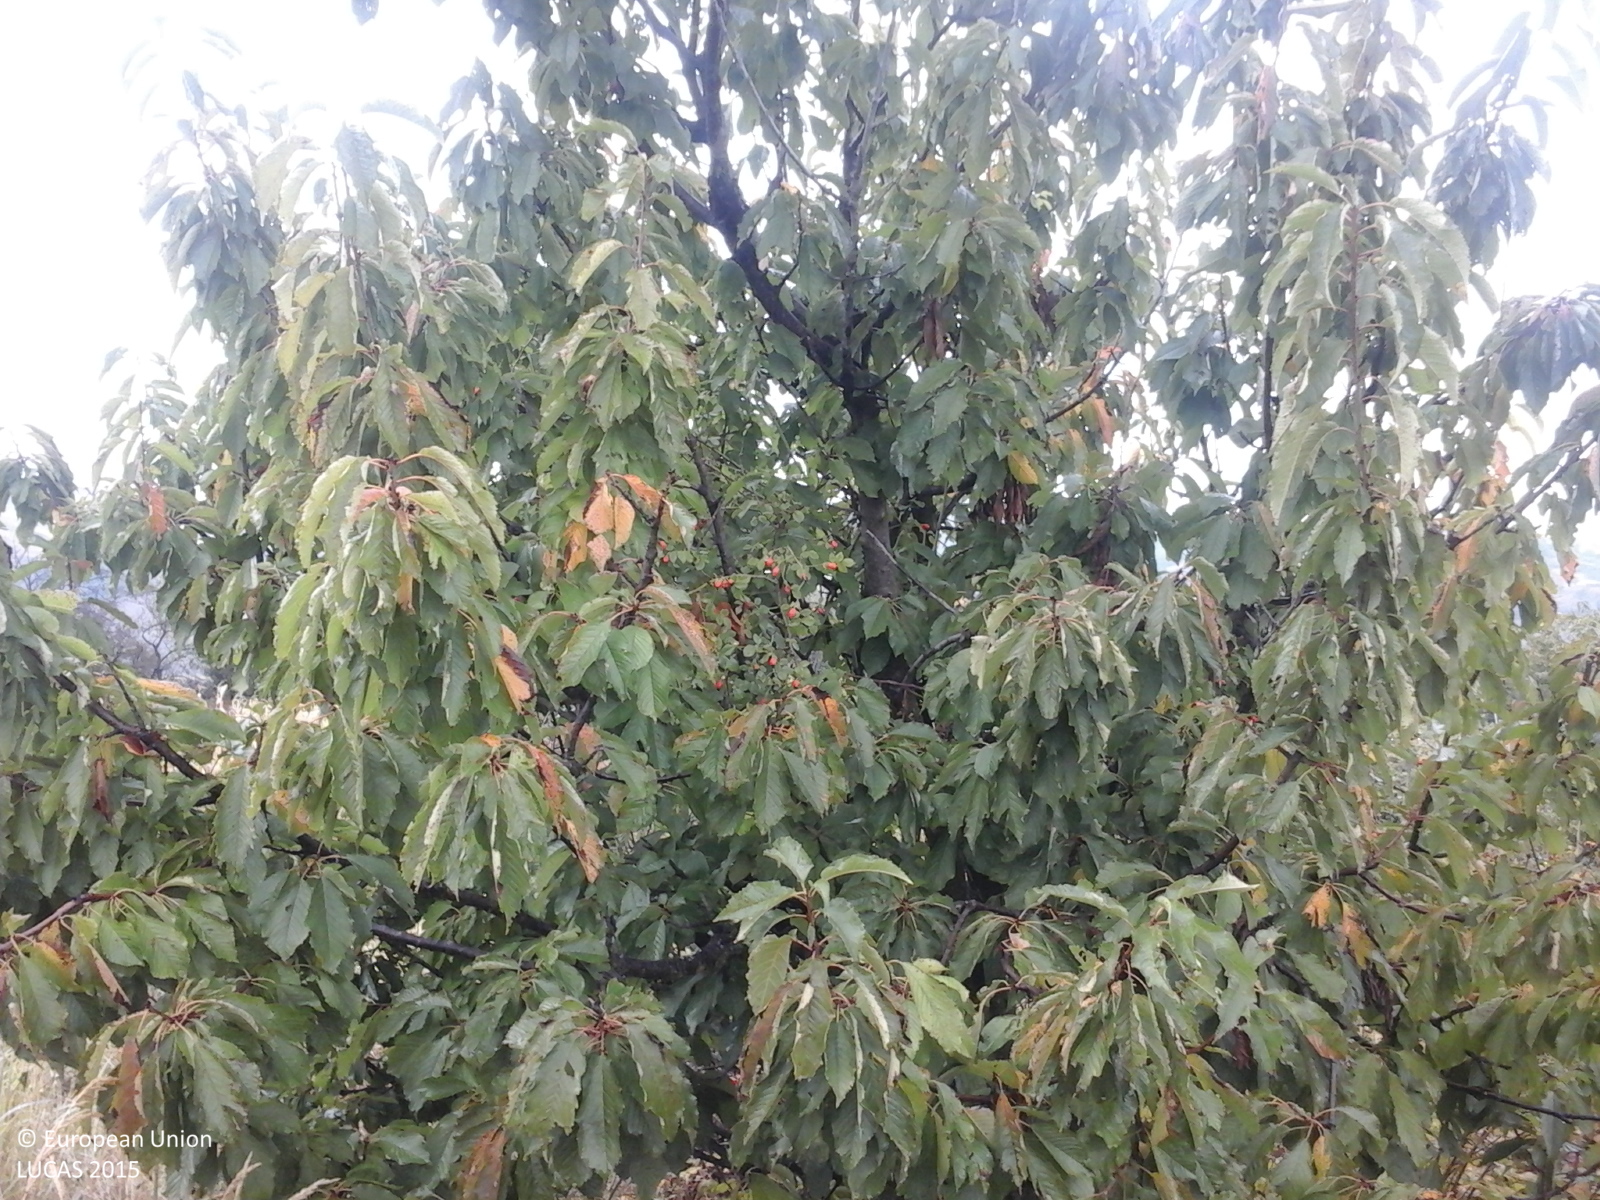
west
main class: Grassland
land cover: Grassland with sparse tree/shrub cover
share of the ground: > 75 %
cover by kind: herbaceous plants 85 %, shrubs 10 %, broadleaved forest trees 5 %
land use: Fallow land
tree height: < 5 m
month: September
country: RO
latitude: 47.3698
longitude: 22.5986
